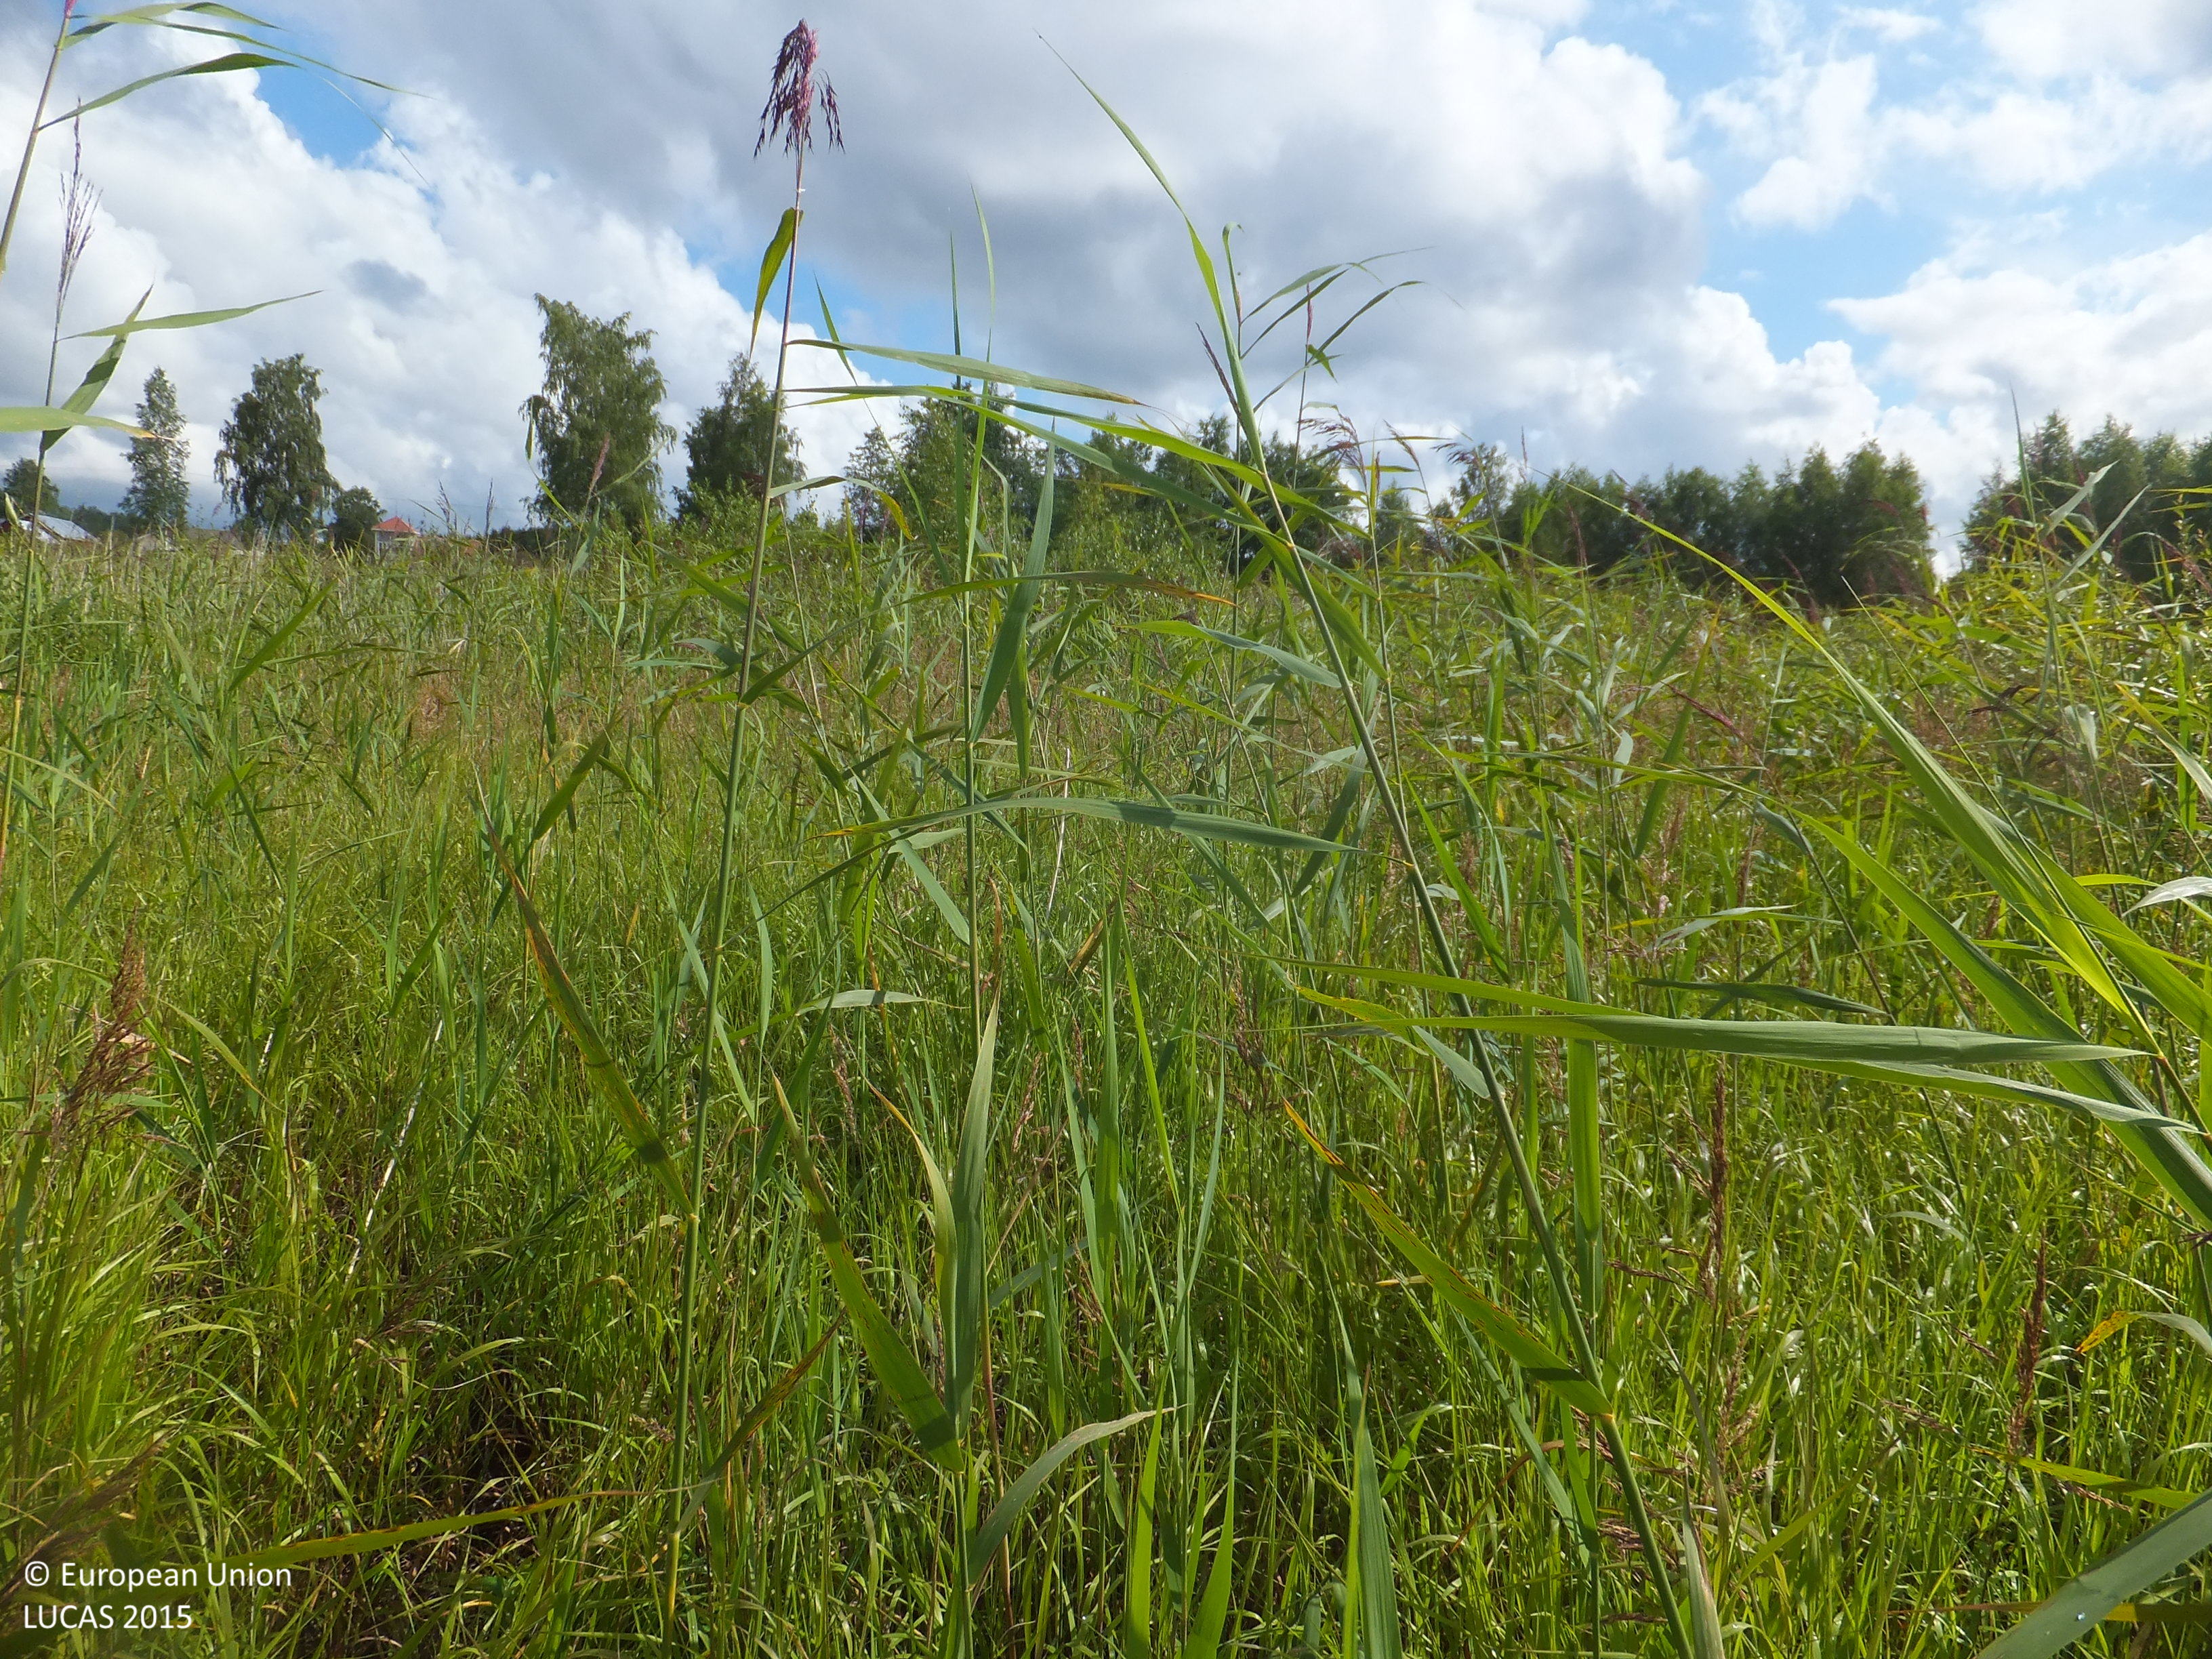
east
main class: Grassland
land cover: Grassland without tree/shrub cover
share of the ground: > 75 %
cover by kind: herbaceous plants 100 %
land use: Semi-natural and natural areas not in use
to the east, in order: Grassland without tree/shrub cover; Shrubland without tree cover; Grassland without tree/shrub cover; Grassland with sparse tree/shrub cover; Broadleaved woodland; Grassland with sparse tree/shrub cover; Electric lines; Grassland with sparse tree/shrub cover; Grassland without tree/shrub cover; Ditches and canals; Grassland without tree/shrub cover; Artificial constructions in urban areas
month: July
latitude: 63.2243
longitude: 22.0414
